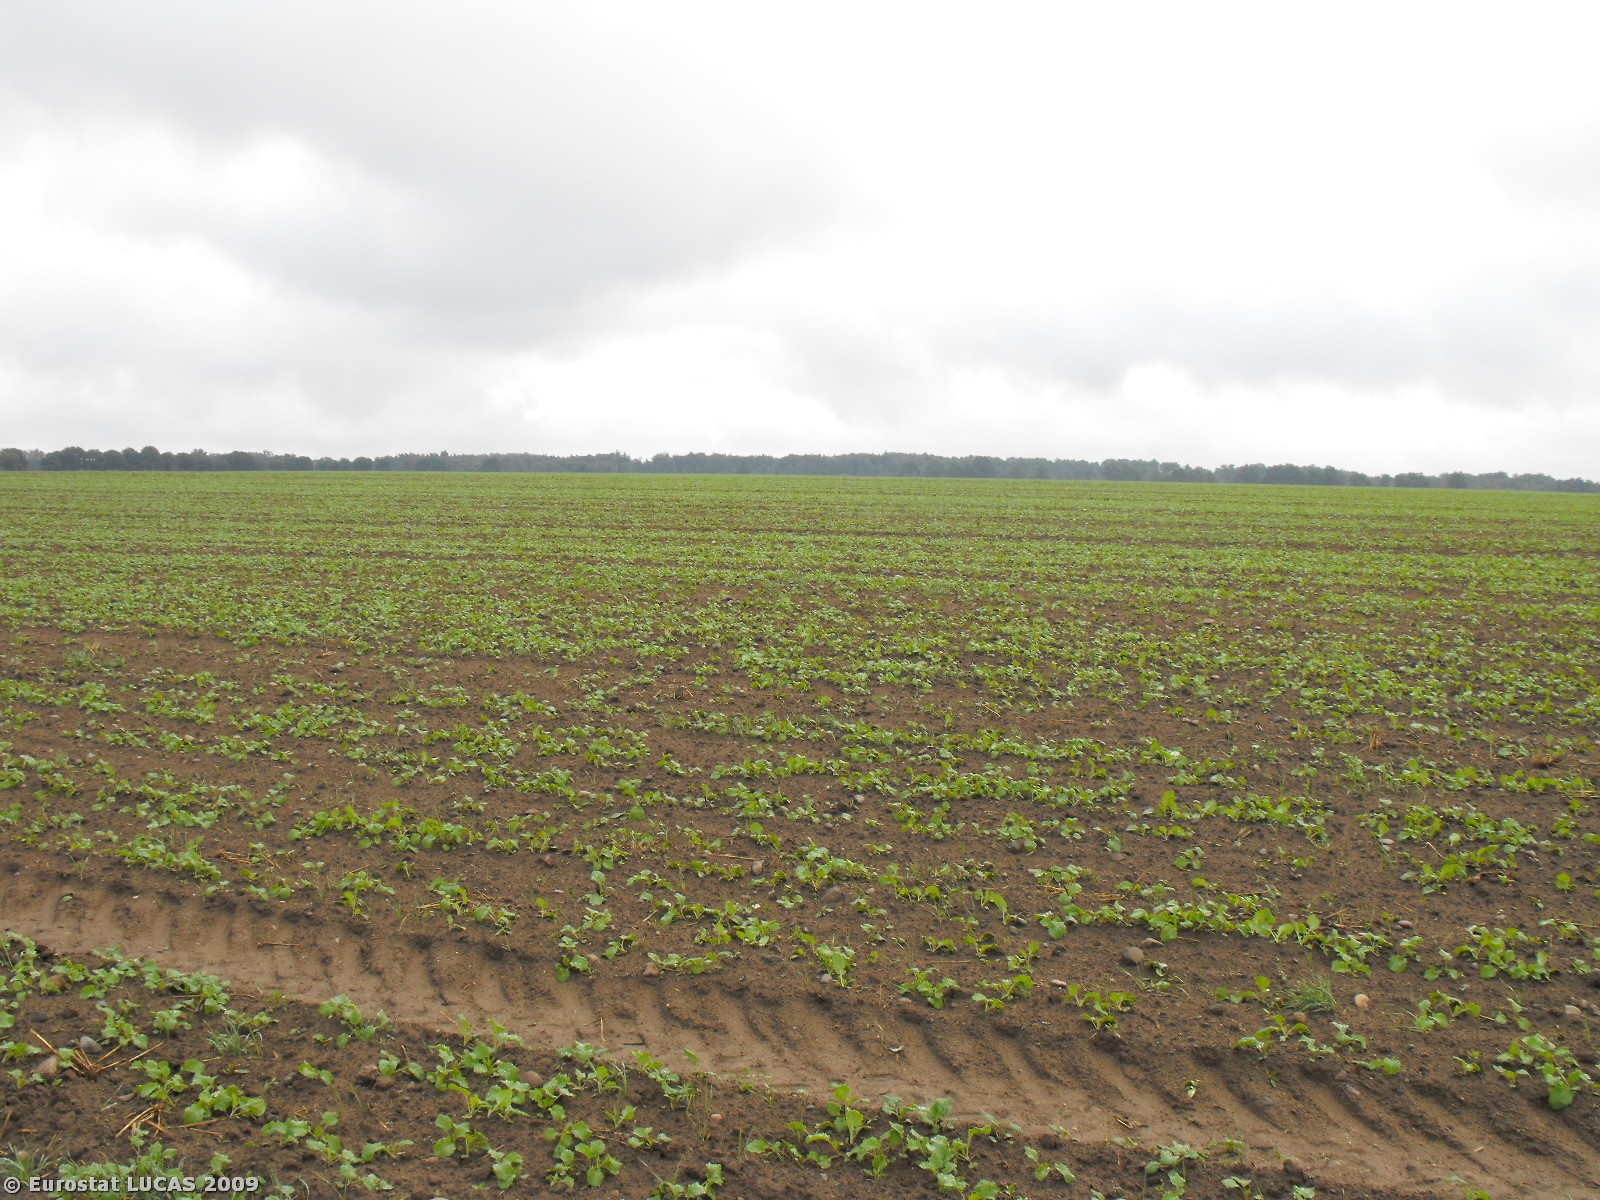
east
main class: Cropland
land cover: Triticale
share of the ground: < 10 %
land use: Agriculture (excluding fallow land and kitchen gardens)
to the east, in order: Triticale
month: September
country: PL
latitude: 53.4979
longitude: 17.1401
